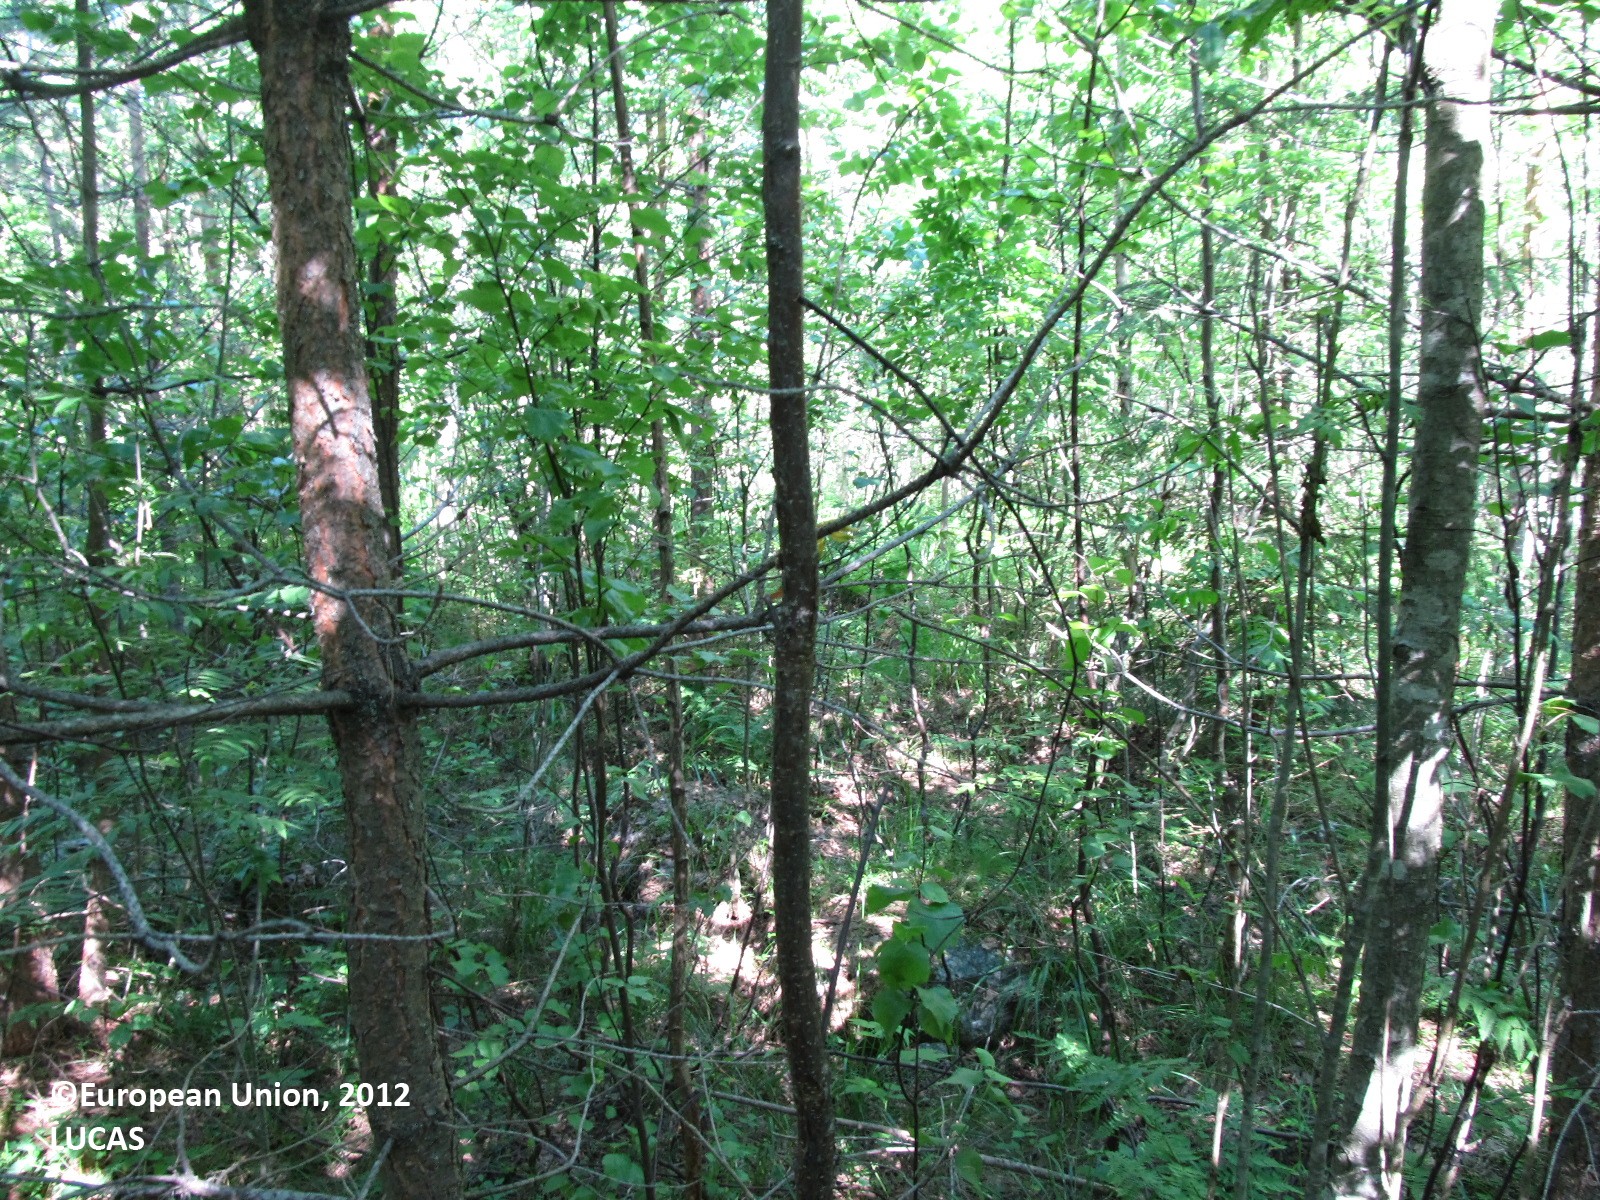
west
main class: Woodland
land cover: Broadleaved woodland
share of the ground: > 75 %
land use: Forestry
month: July
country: FI
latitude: 62.2091
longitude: 29.2469
